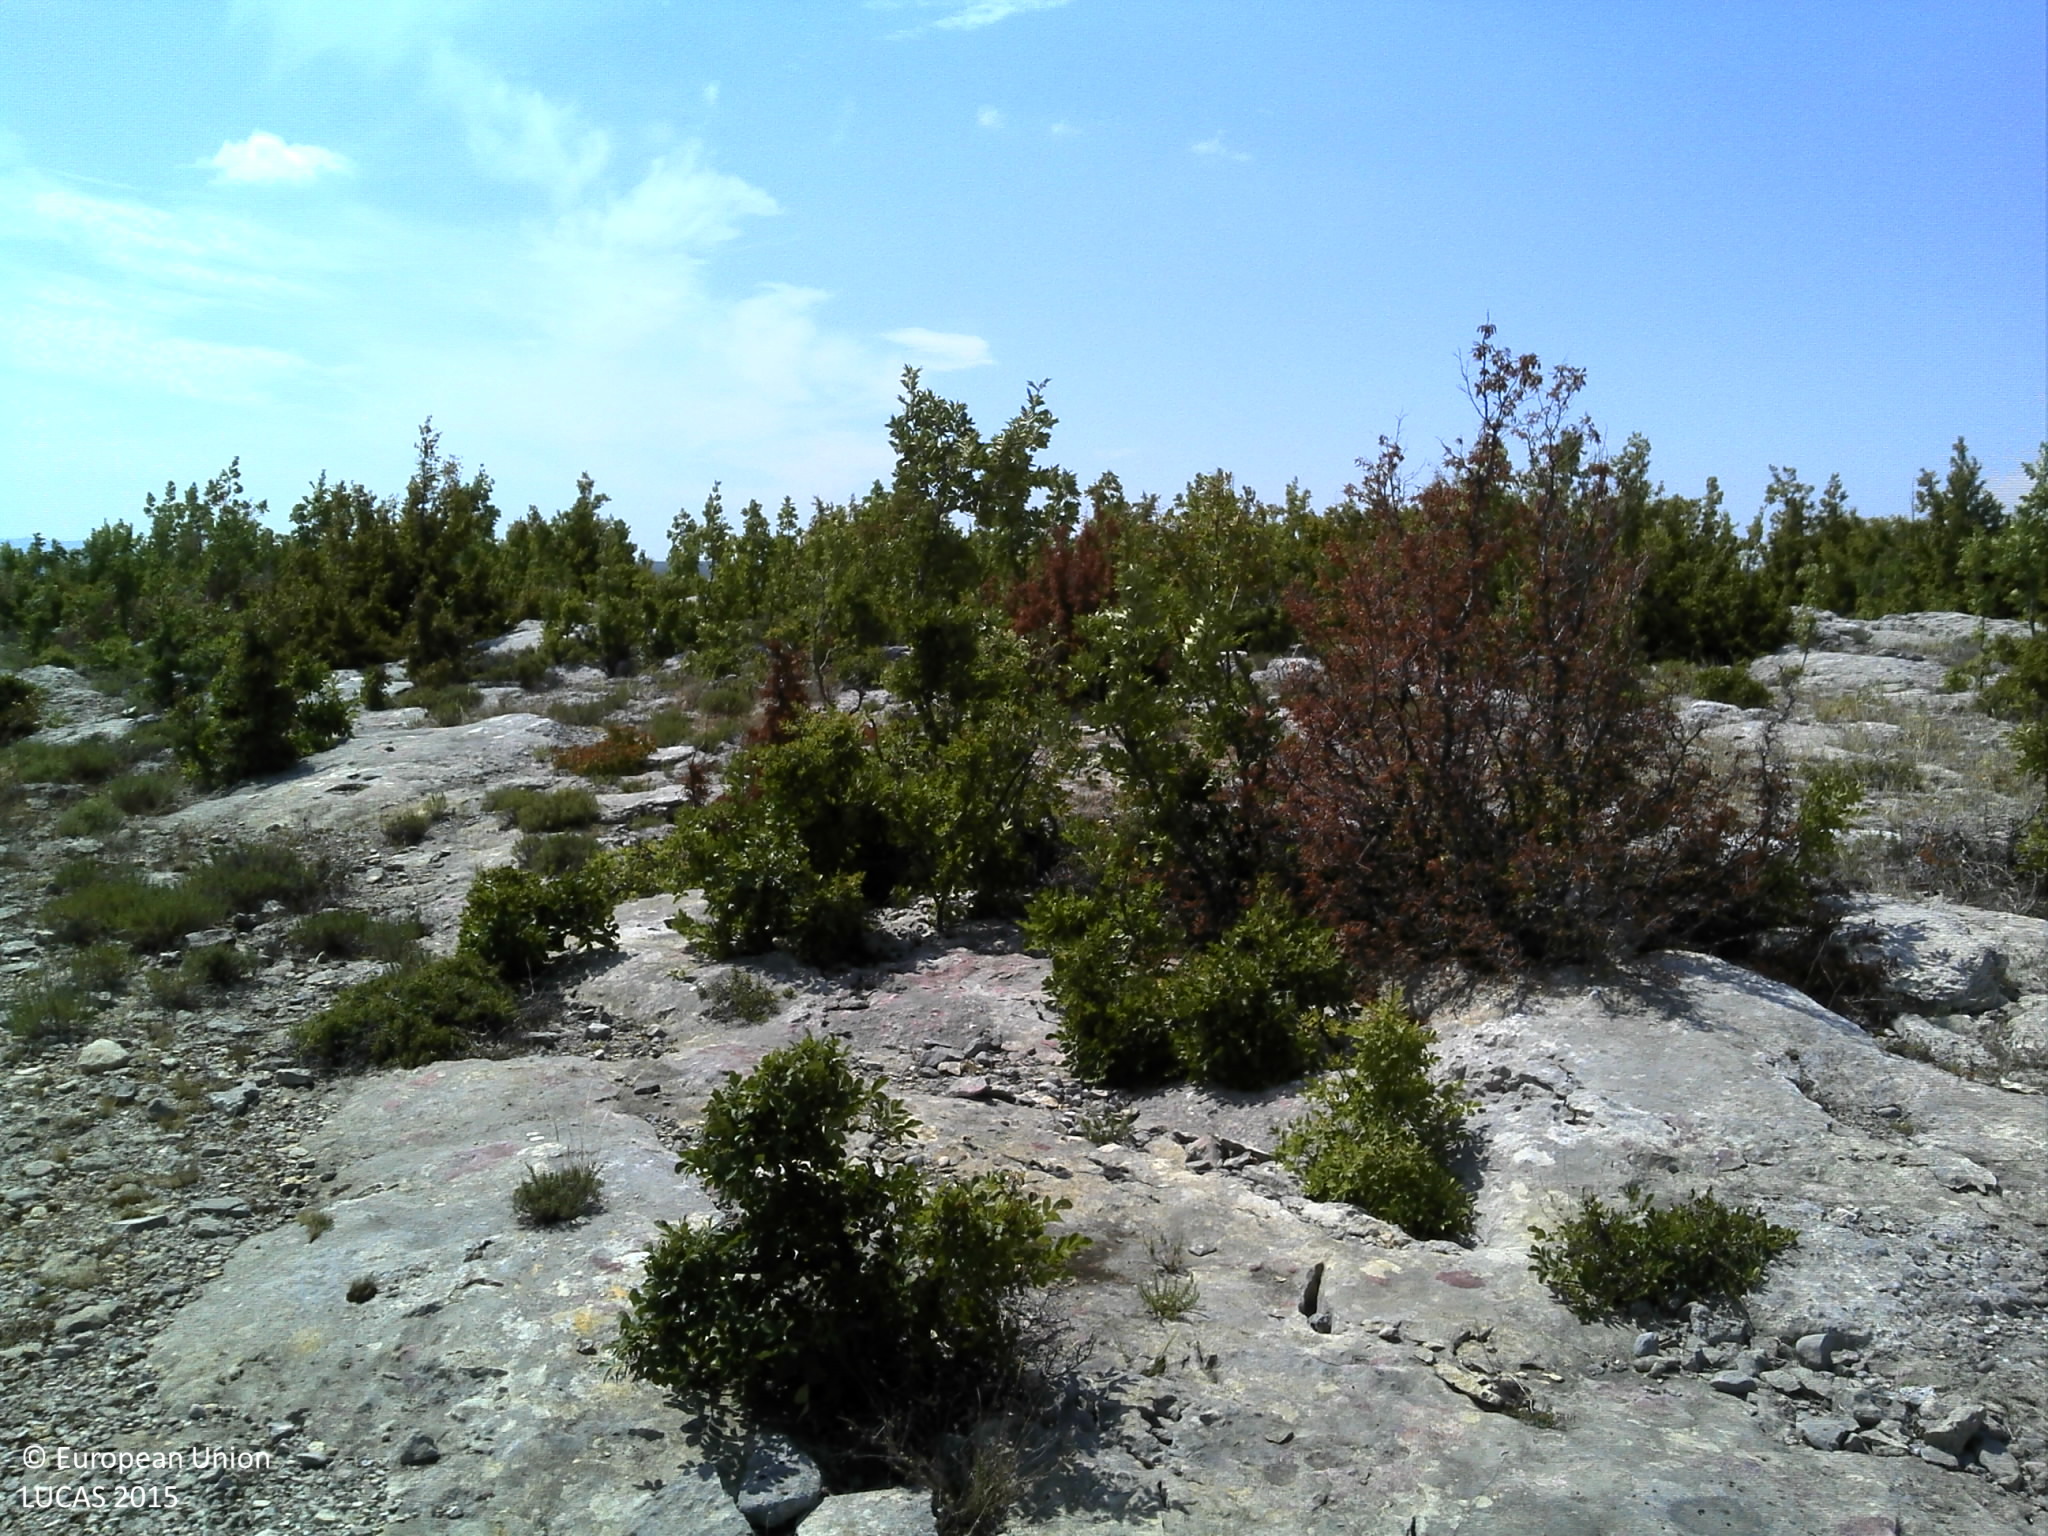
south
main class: Shrubland
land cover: Shrubland without tree cover
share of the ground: 25 - 50 %
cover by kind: shrubs 30 %, unconsolidated bare surface 30 %, herbaceous plants 20 %, consolidated bare surface 20 %
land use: Abandoned areas
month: August
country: HR
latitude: 44.0771
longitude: 15.8487
